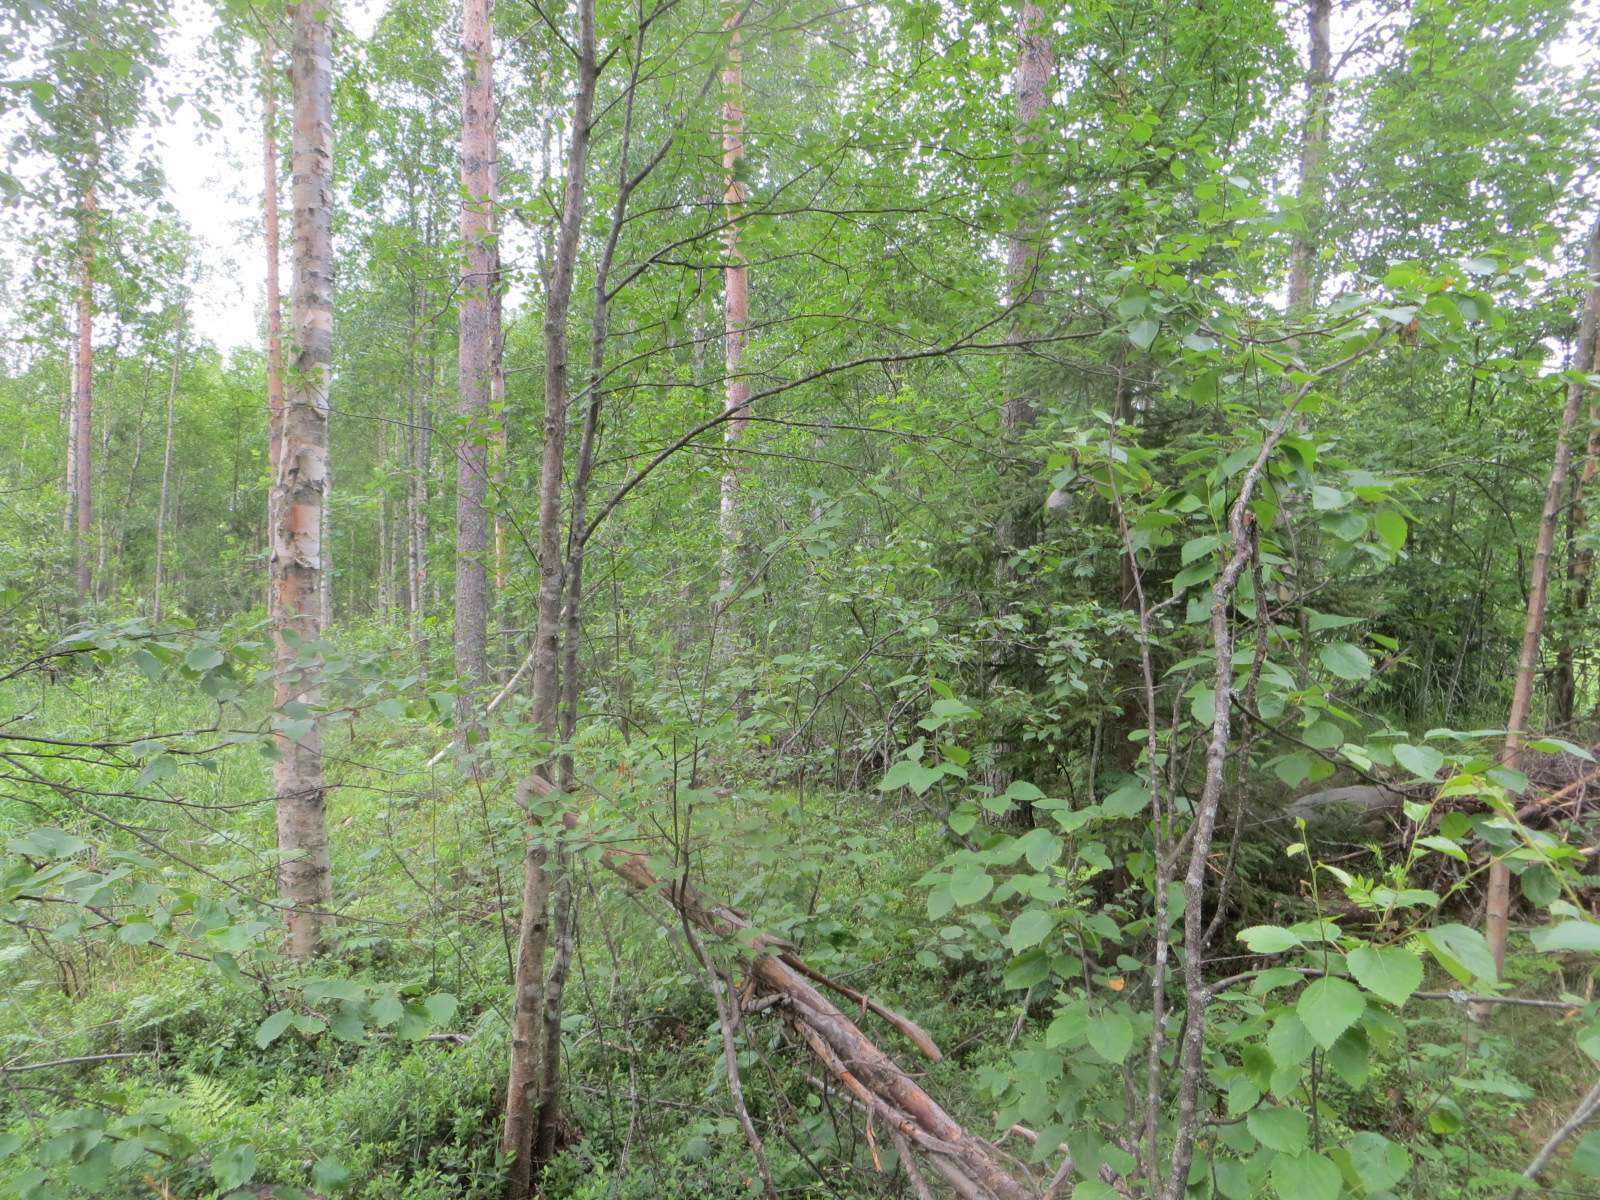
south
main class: Woodland
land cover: Other mixed woodland
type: boreal forest
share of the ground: 50 - 75 %
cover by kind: shrubs 45 %, coniferous forest trees 35 %, broadleaved forest trees 20 %
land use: Forestry
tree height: > 5 m
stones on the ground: 10 - 25 %
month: July
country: FI
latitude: 65.7146
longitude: 25.1682
